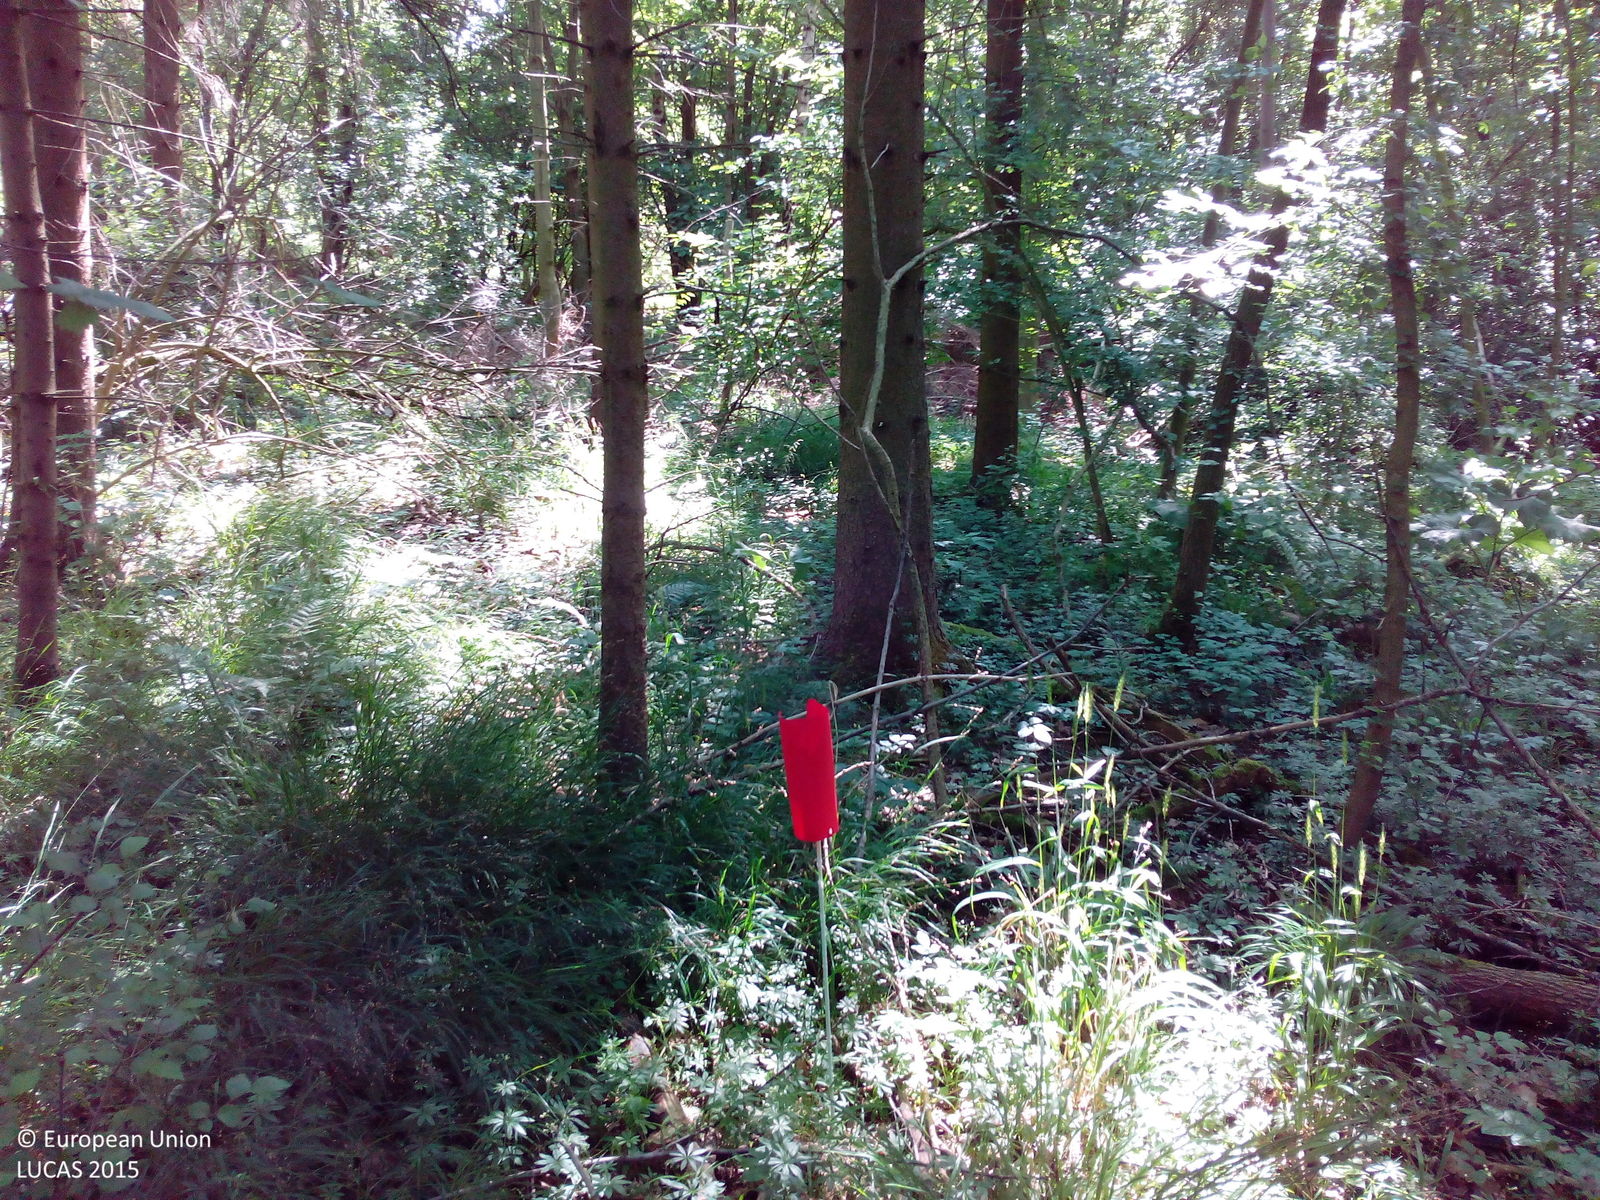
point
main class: Woodland
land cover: Spruce dominated mixed woodland
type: hemiboreal forest and nemoral coniferous forest and mixed broadleaved-coniferous forest
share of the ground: > 75 %
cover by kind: broadleaved forest trees 65 %, coniferous forest trees 25 %, herbaceous plants 10 %
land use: Community services
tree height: > 5 m
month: June
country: DE
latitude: 51.8381
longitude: 9.8694
